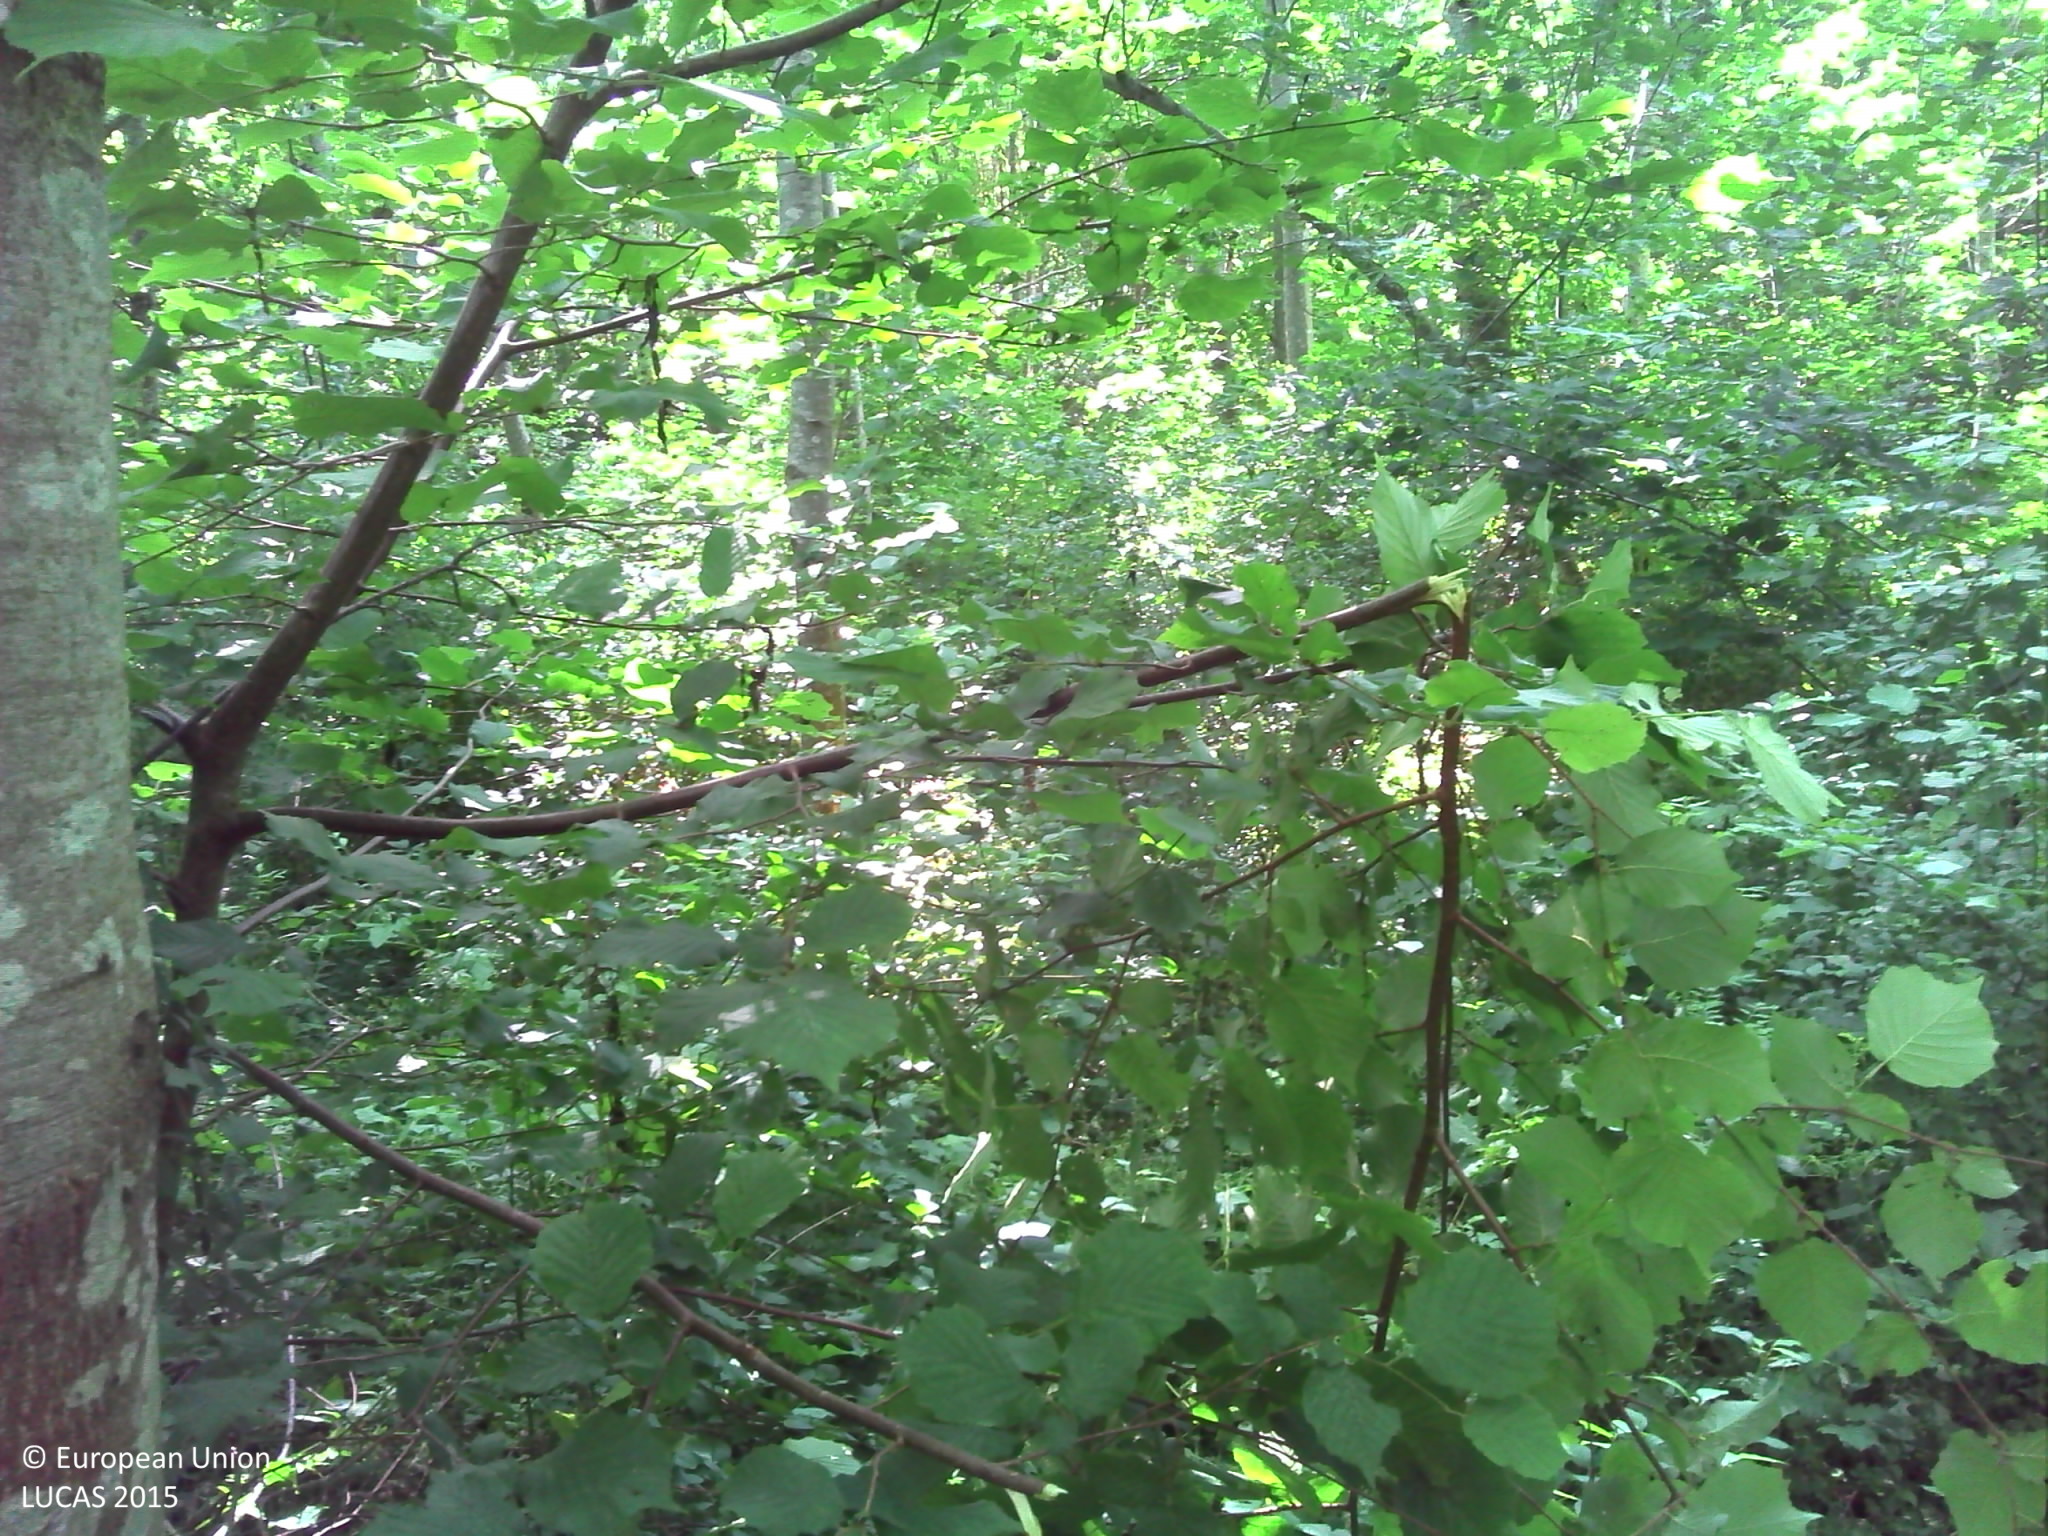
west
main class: Woodland
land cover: Broadleaved woodland
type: acidophilous oak and oak-birch forest
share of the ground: > 75 %
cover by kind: broadleaved forest trees 100 %
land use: Forestry
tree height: > 5 m
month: June
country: FR
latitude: 45.8704
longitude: 0.6727
